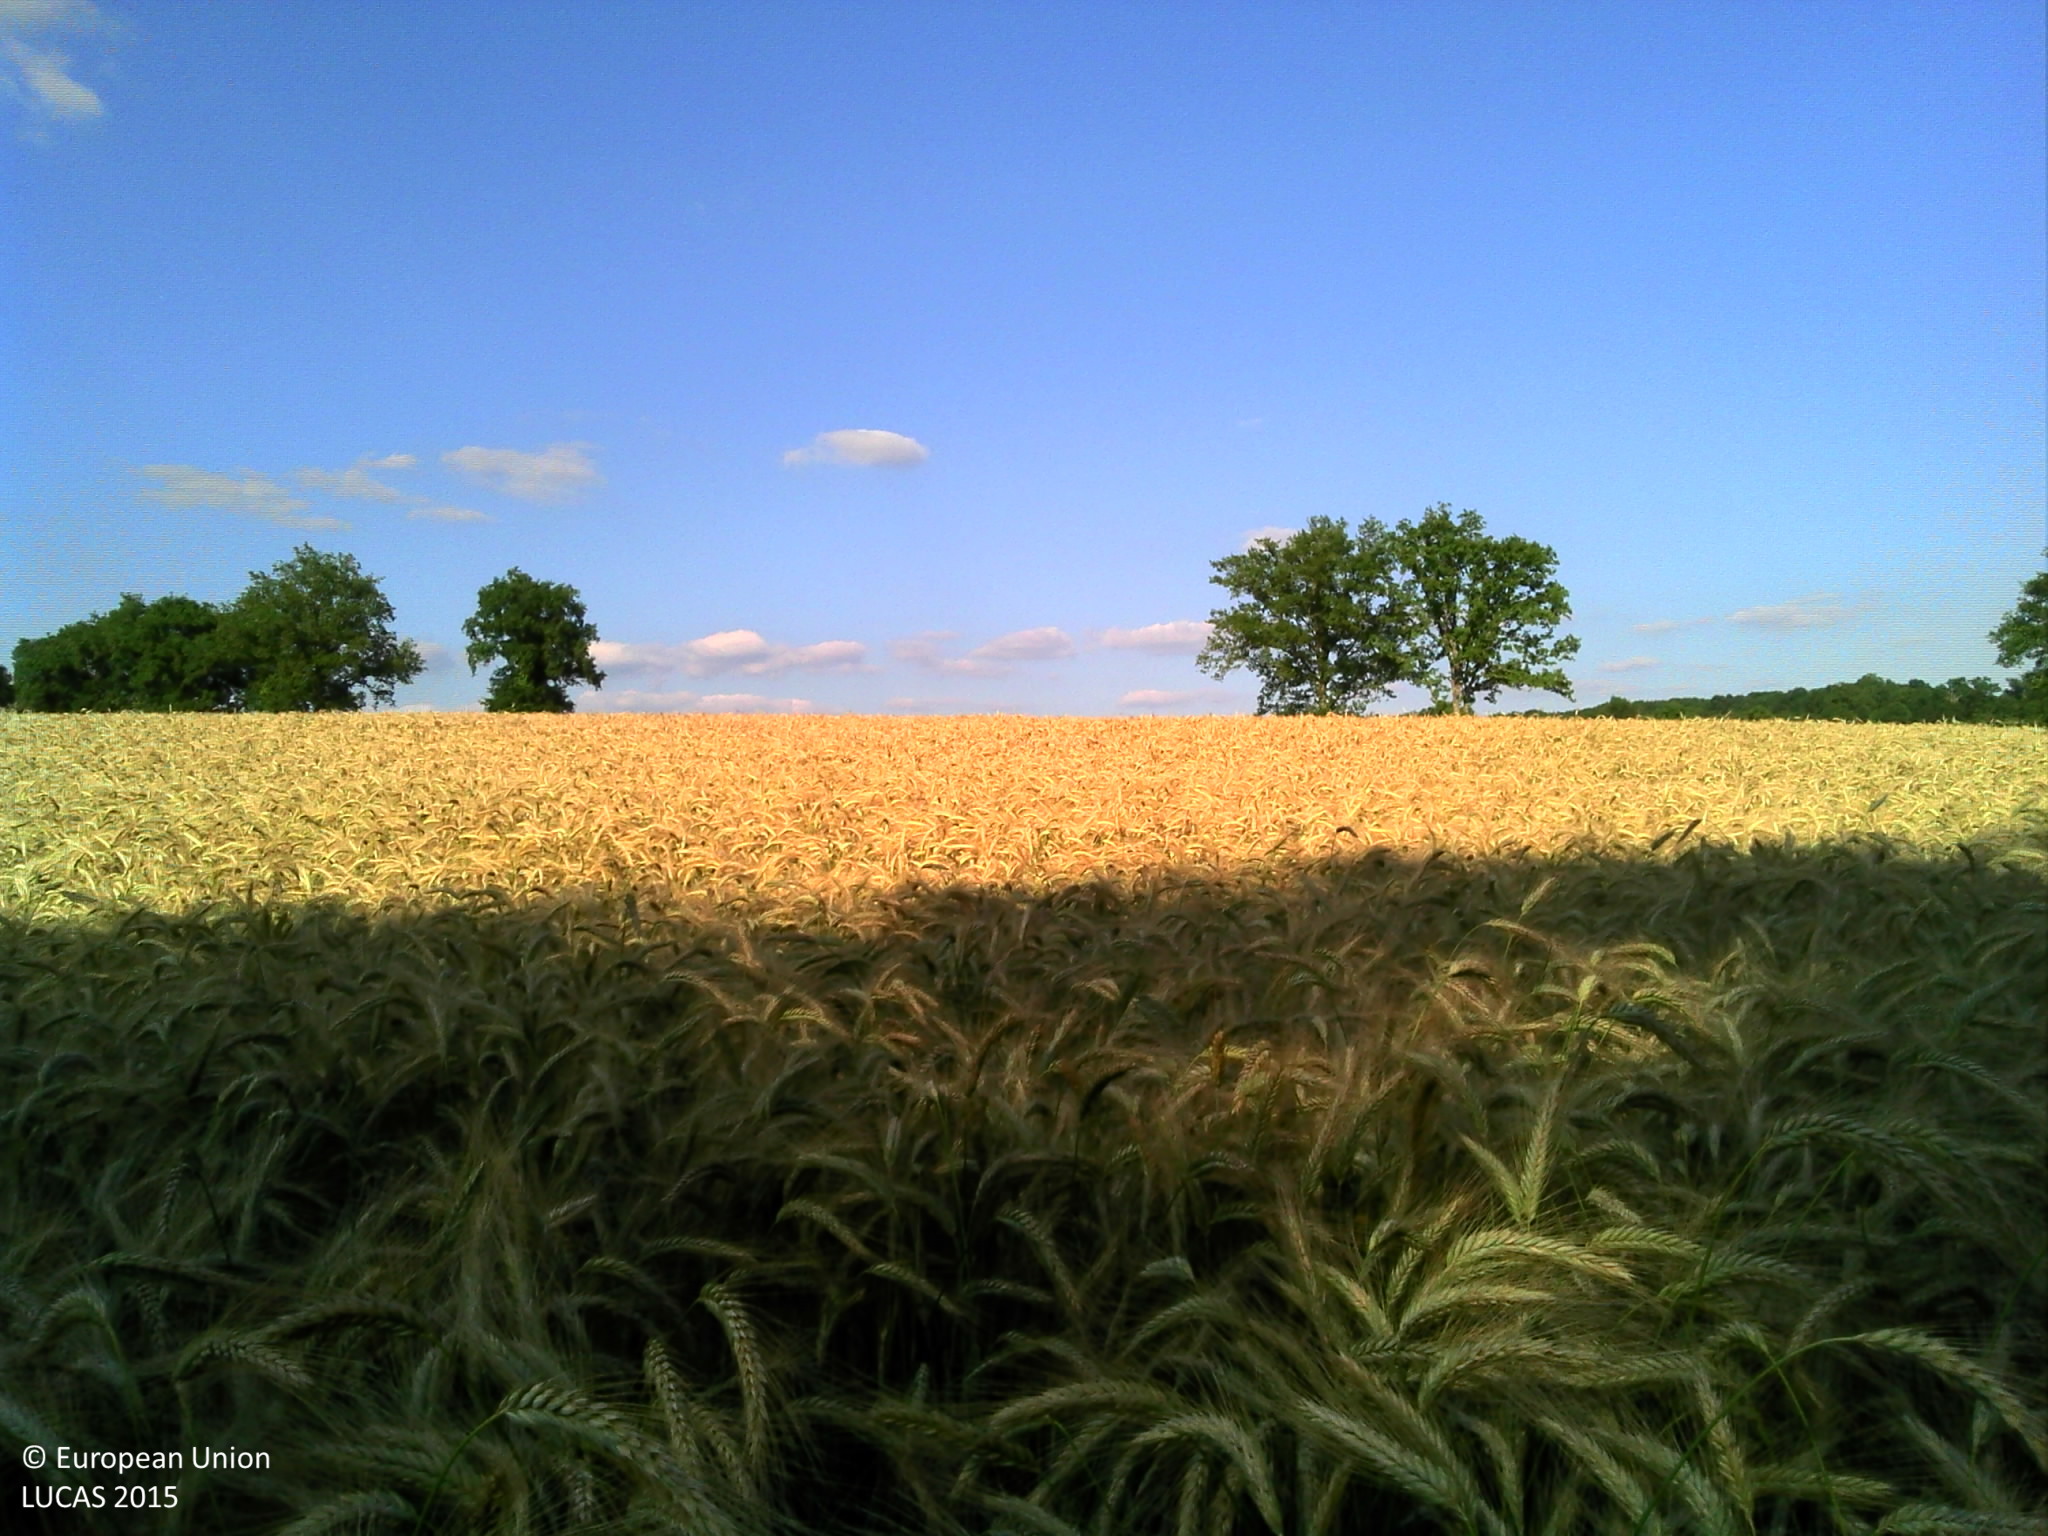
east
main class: Cropland
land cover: Triticale
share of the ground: > 75 %
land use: Agriculture (excluding fallow land and kitchen gardens)
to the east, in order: Triticale; Managed hedges; Fences; Triticale
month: June
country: FR
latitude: 45.9418
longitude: 0.6603
